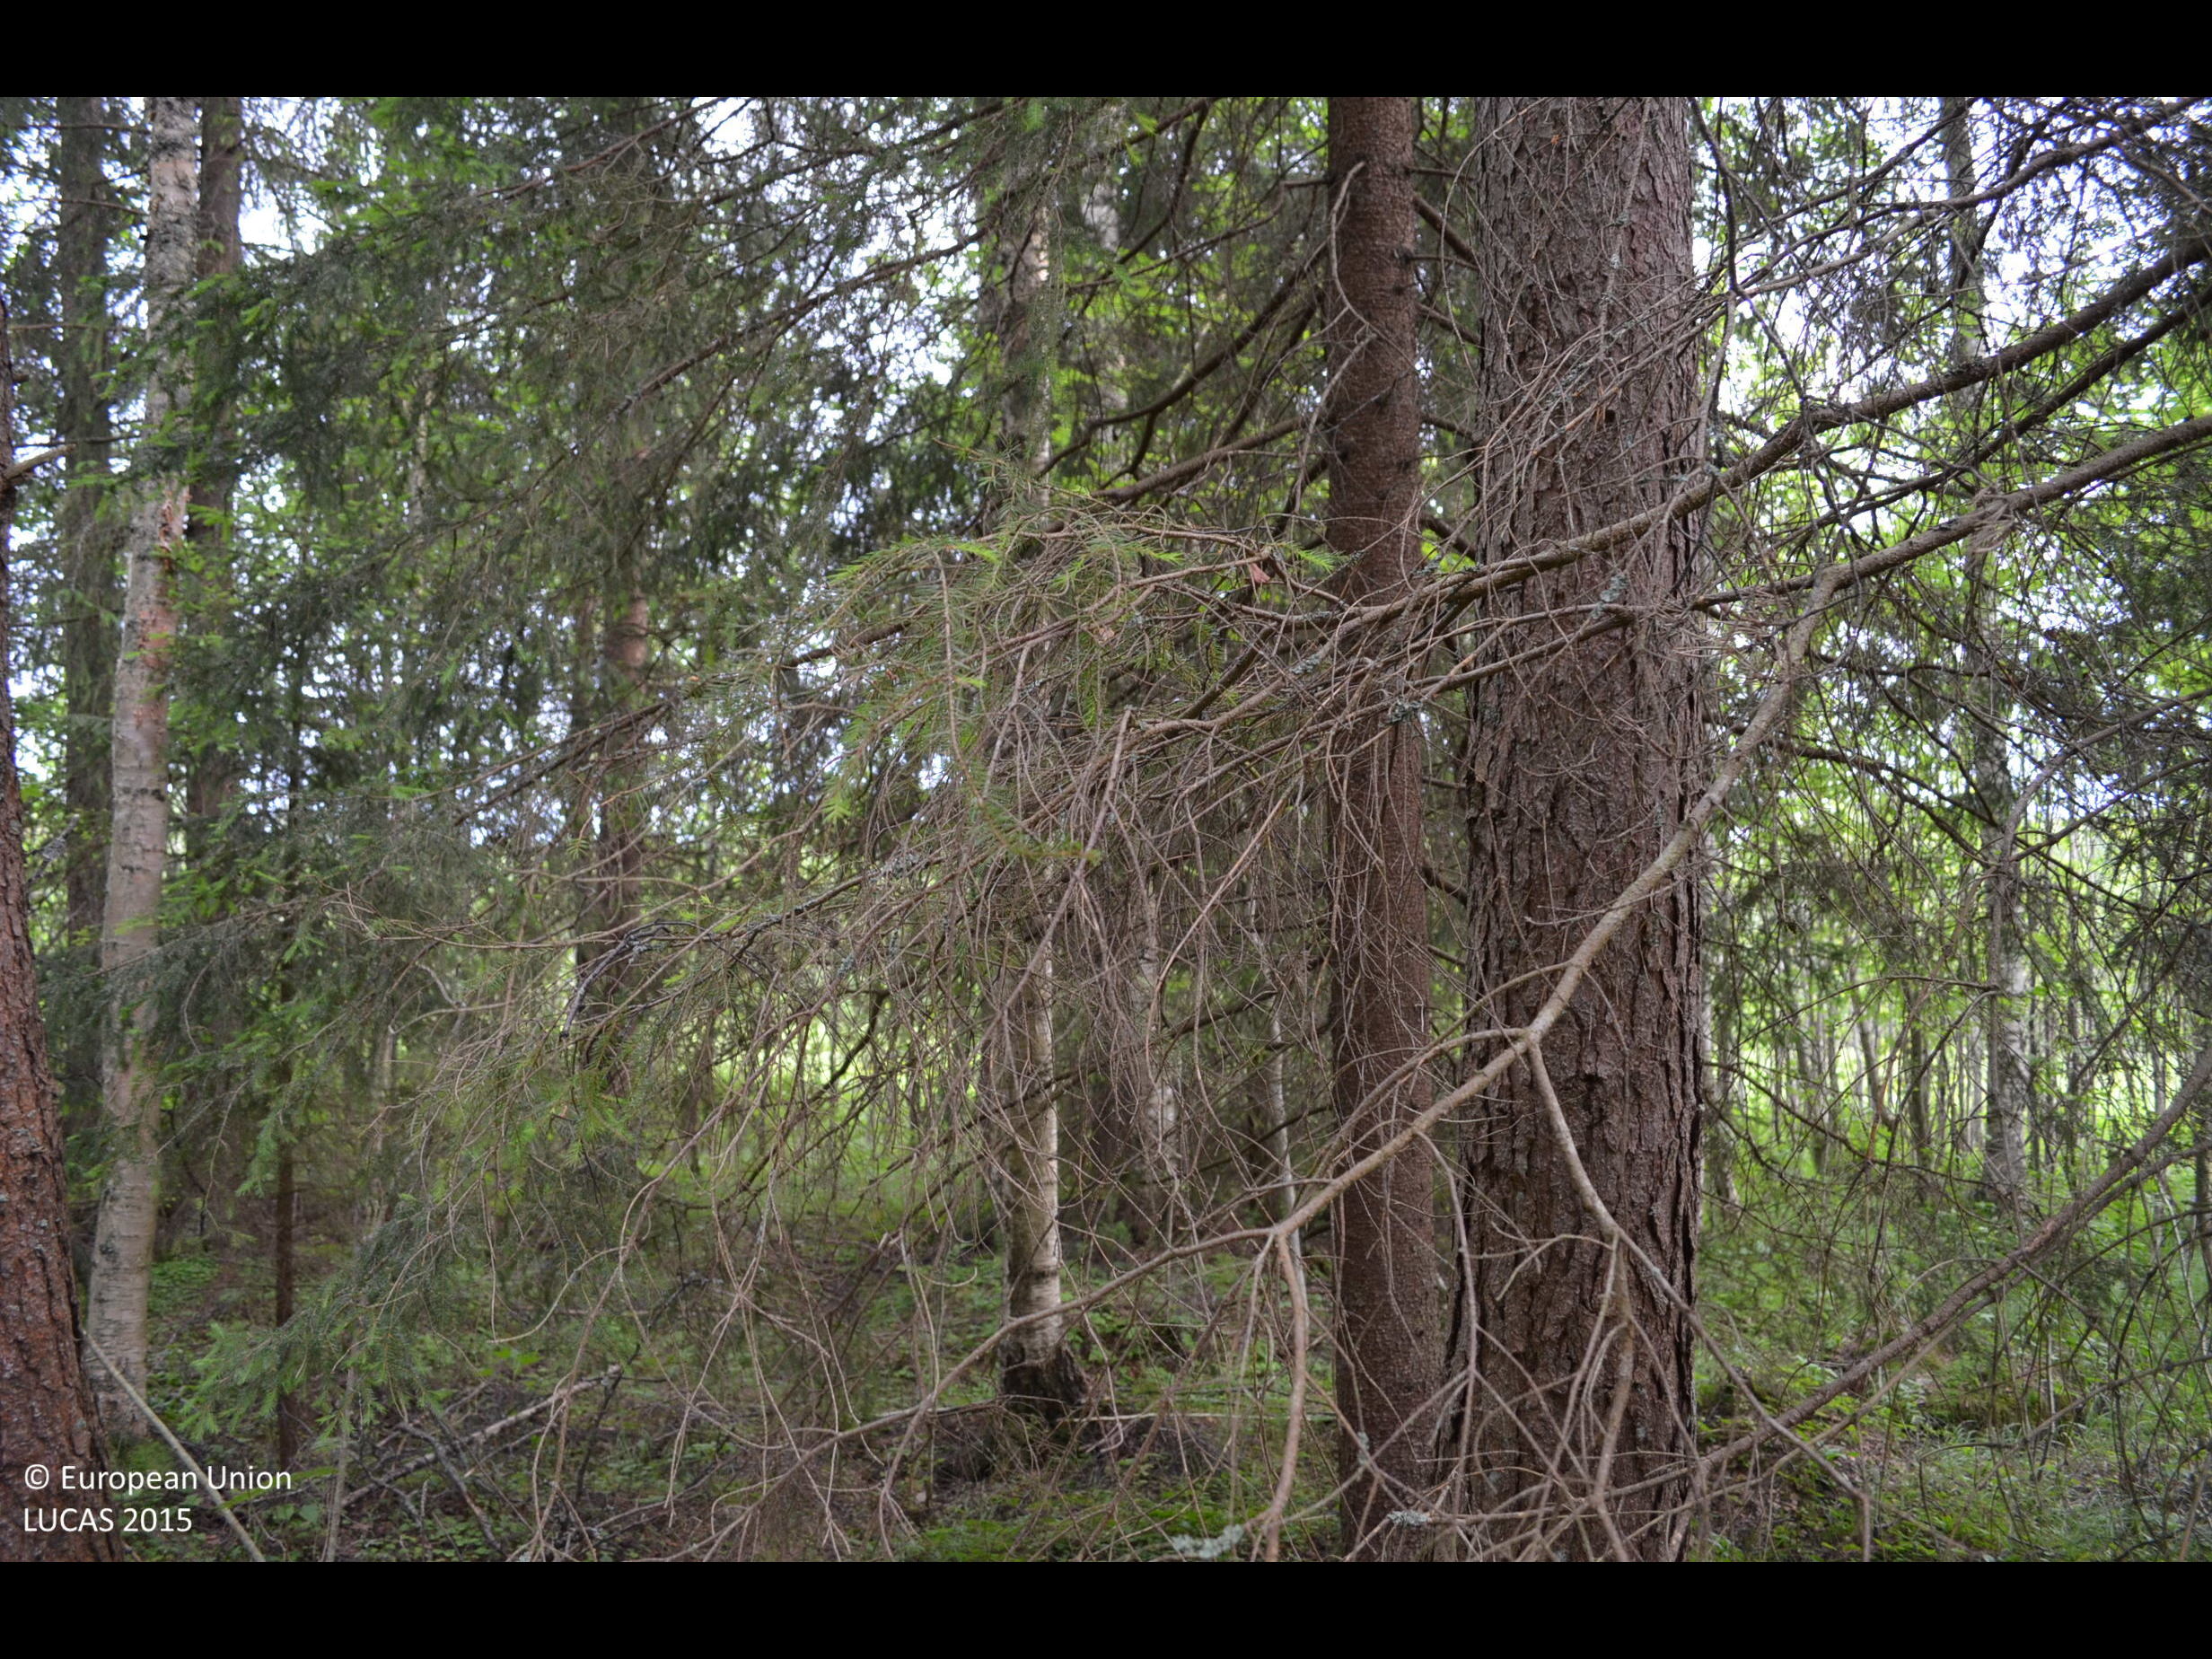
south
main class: Woodland
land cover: Other mixed woodland
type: boreal forest
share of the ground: > 75 %
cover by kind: coniferous forest trees 50 %, broadleaved forest trees 35 %, shrubs 10 %, herbaceous plants 5 %
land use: Forestry
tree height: > 5 m
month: June
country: FI
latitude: 61.8103
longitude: 23.3769
